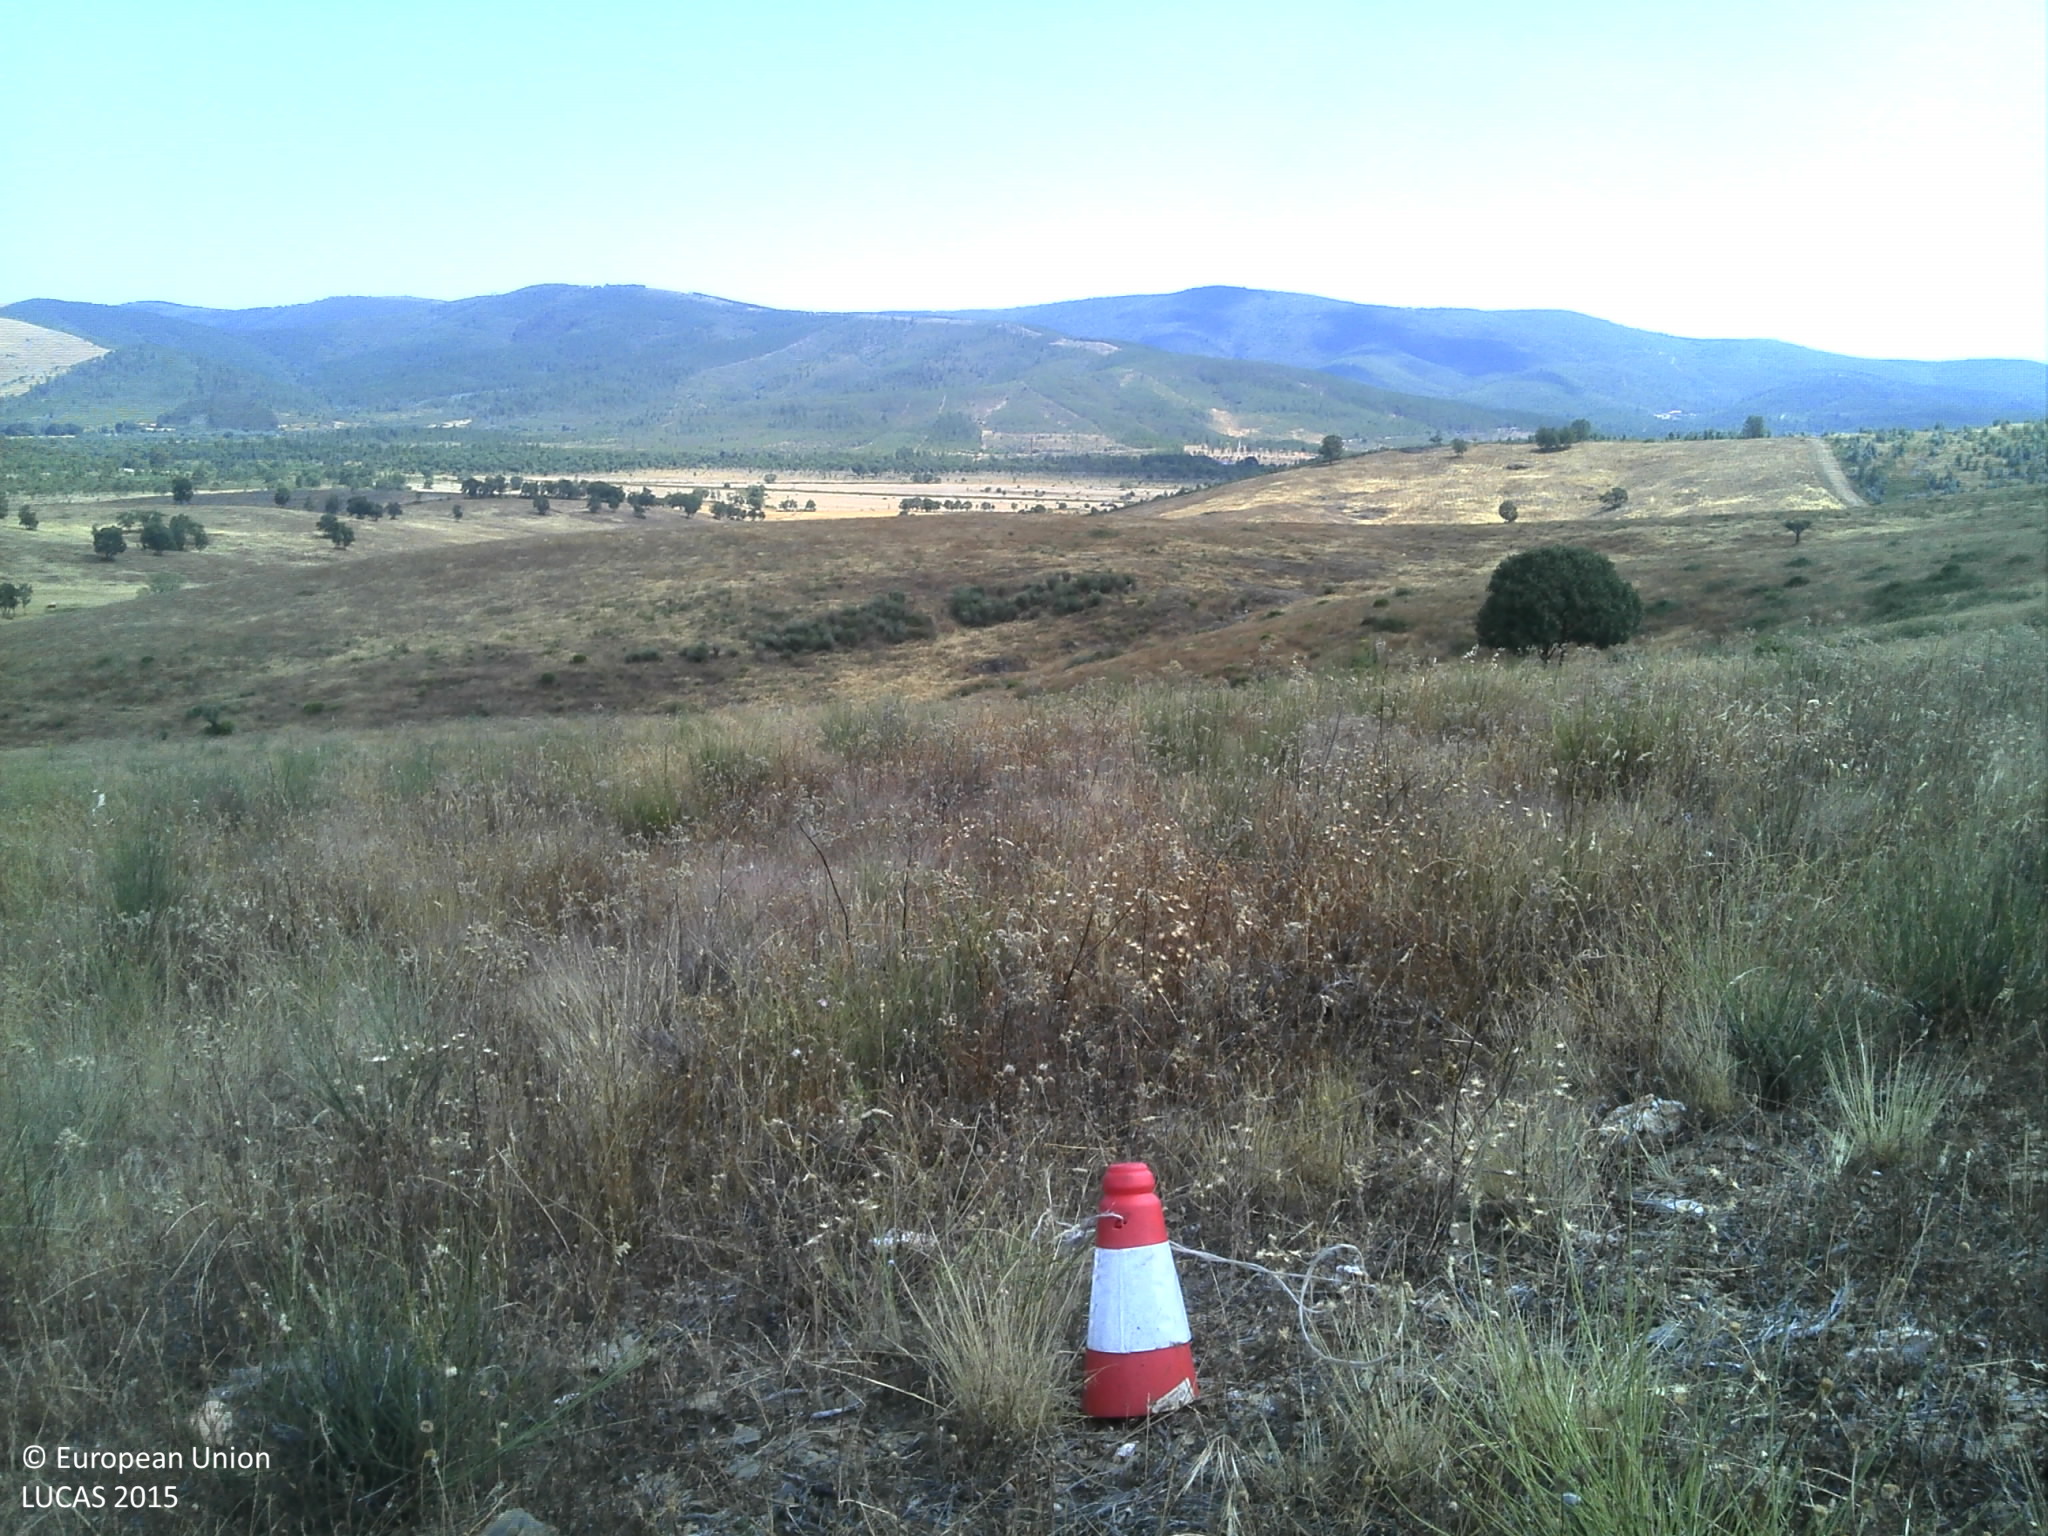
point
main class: Grassland
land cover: Grassland with sparse tree/shrub cover
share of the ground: 50 - 75 %
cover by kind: herbaceous plants 65 %, unconsolidated bare surface 25 %, broadleaved forest trees 5 %
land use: Agriculture (excluding fallow land and kitchen gardens)
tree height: > 5 m
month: June
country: PT
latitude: 40.1850
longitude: -7.1389
